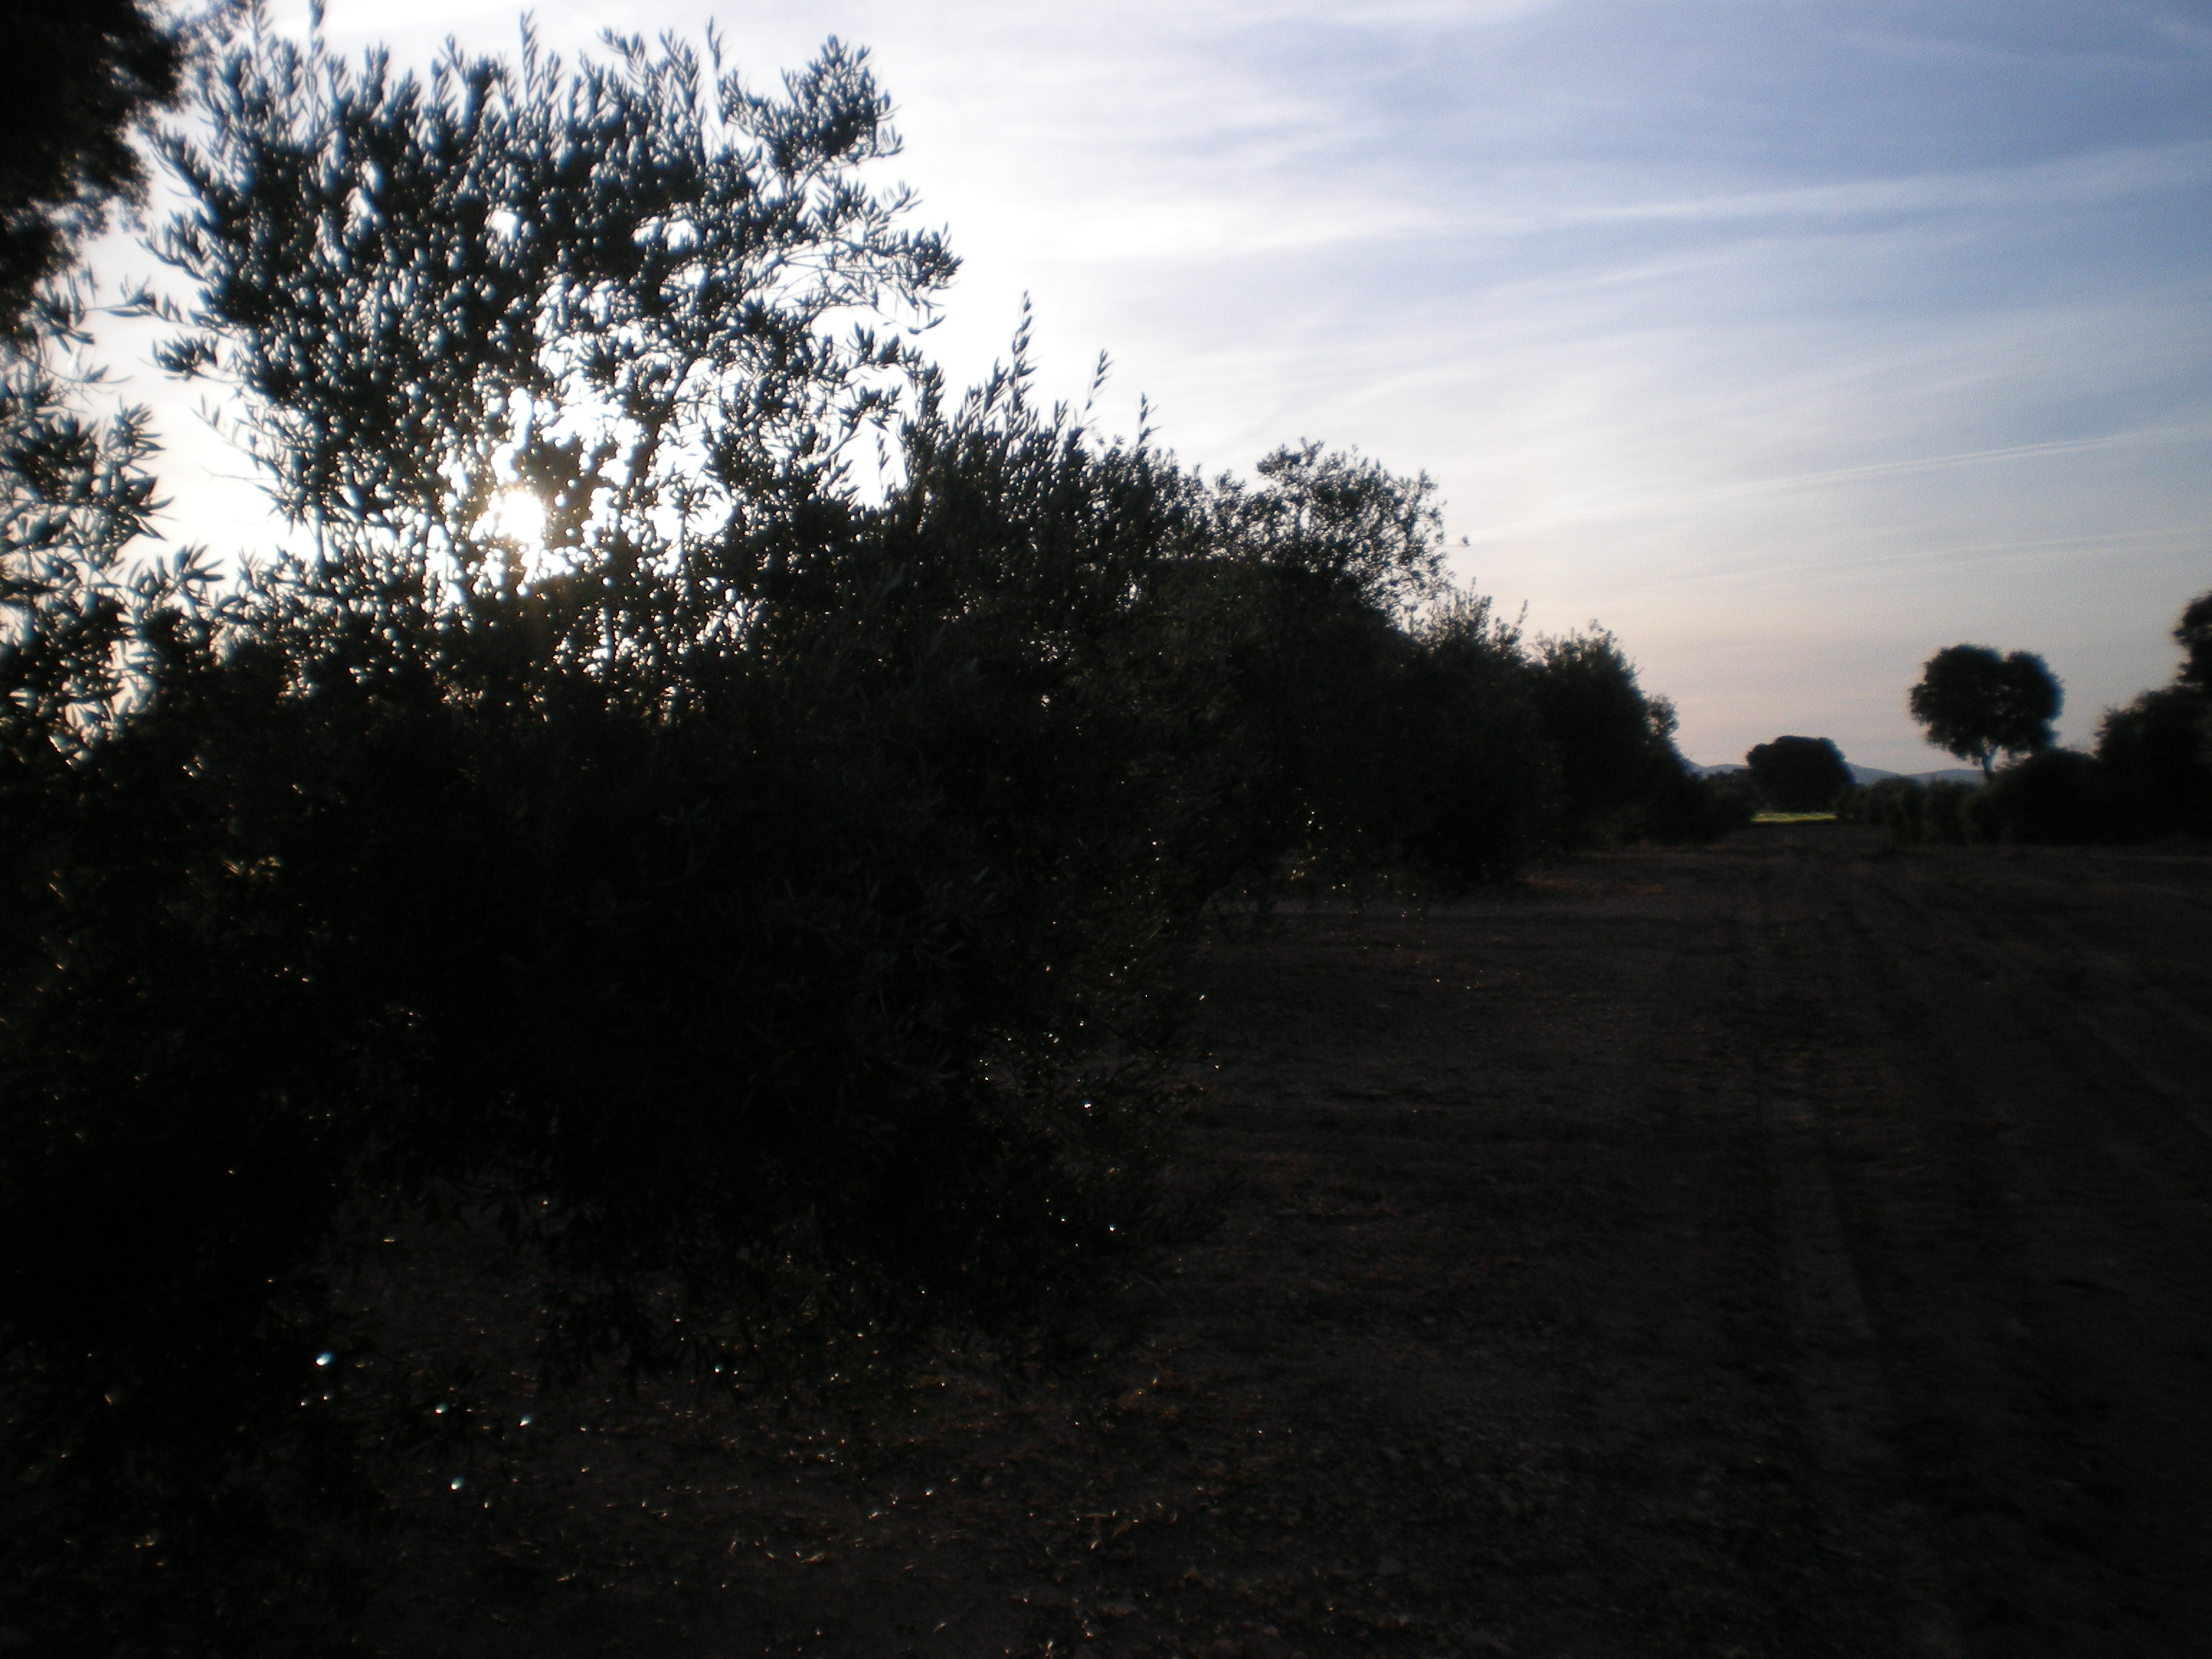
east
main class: Cropland
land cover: Olive groves
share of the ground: 10 - 25 %
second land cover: Other bare soil
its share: > 75 %
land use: Agriculture (excluding fallow land and kitchen gardens)
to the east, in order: Olive groves; Other bare soil; Single bushes/trees; Olive groves; Grass margins; Barley; Grass margins; Tracks; Grass margins; Barley; Single bushes/trees; Barley
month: April
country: ES
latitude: 38.5577
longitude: -3.1220
